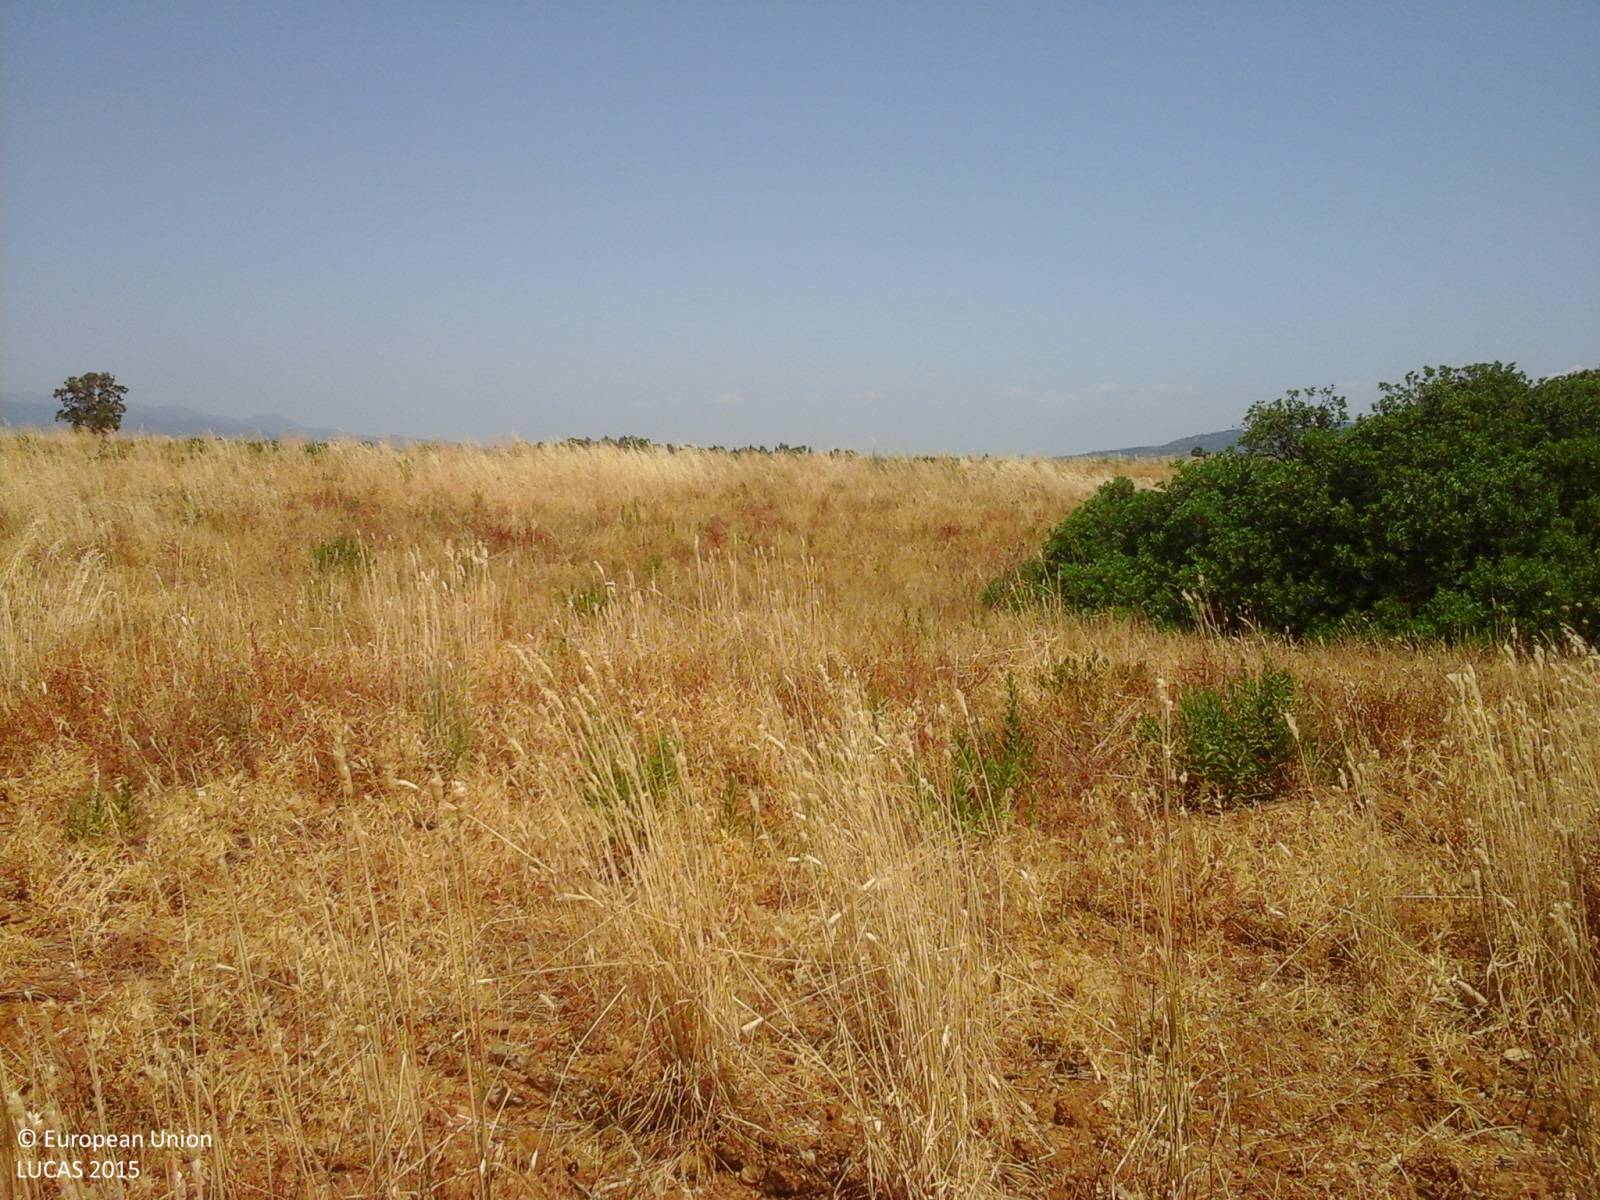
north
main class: Grassland
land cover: Spontaneously vegetated surfaces
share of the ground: > 75 %
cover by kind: herbaceous plants 85 %, unconsolidated bare surface 15 %
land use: Agriculture (excluding fallow land and kitchen gardens)
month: June
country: IT
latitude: 39.2639
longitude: 8.8136
